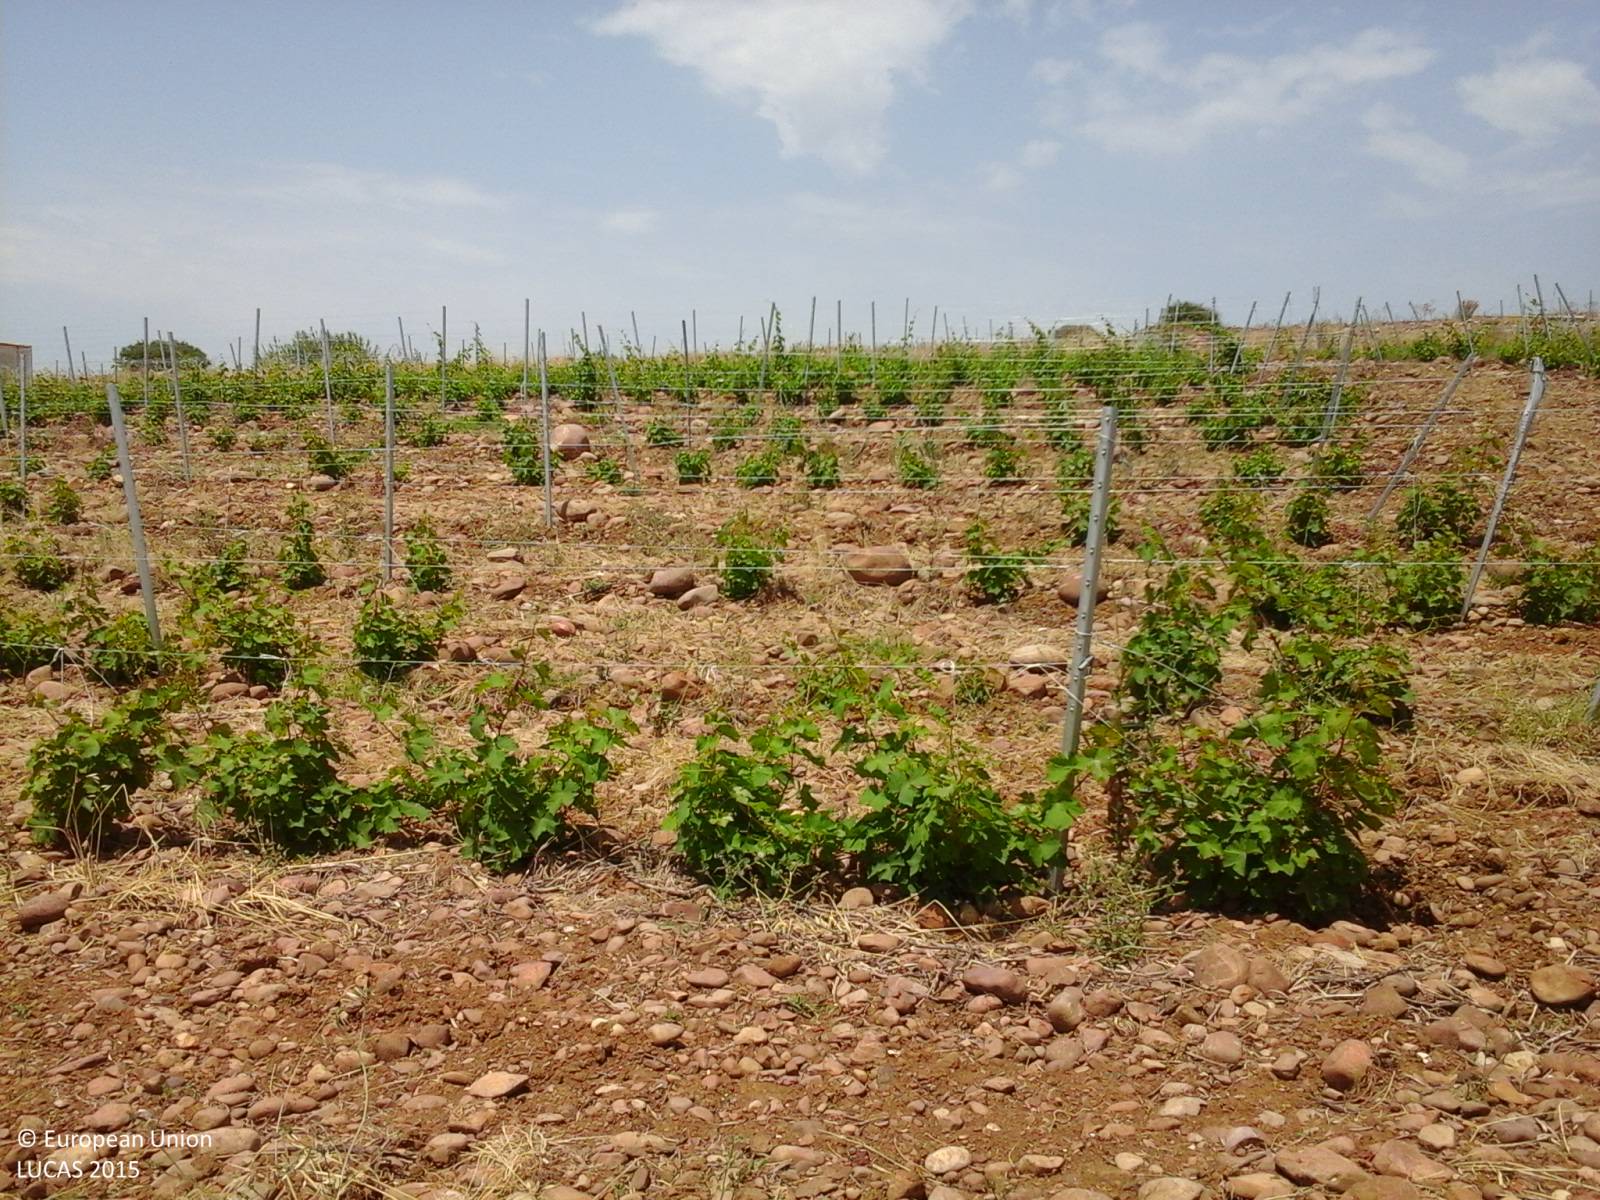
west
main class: Cropland
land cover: Vineyards
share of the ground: 25 - 50 %
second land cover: Other bare soil
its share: > 75 %
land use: Agriculture (excluding fallow land and kitchen gardens)
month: June
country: IT
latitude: 37.8177
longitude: 12.7175
